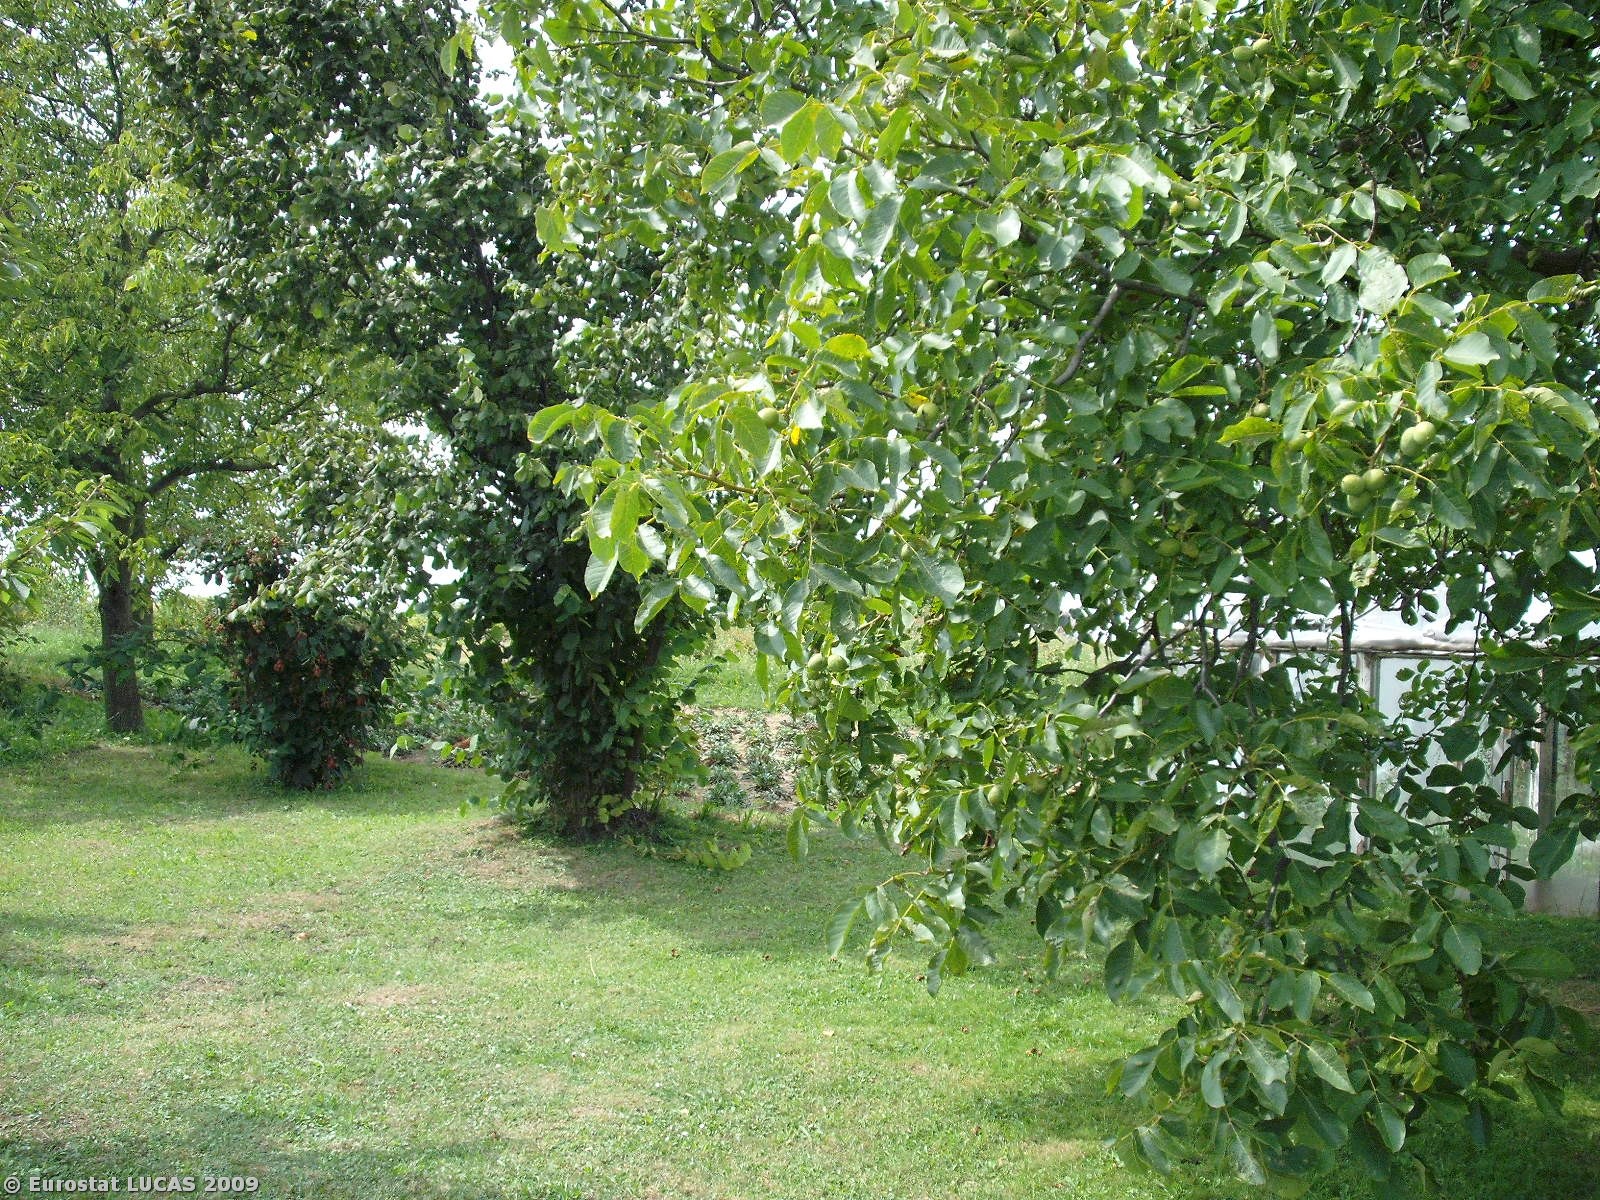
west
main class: Grassland
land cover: Grassland without tree/shrub cover
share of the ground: > 75 %
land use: Residential
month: August
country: PL
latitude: 50.0713
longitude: 22.3725
